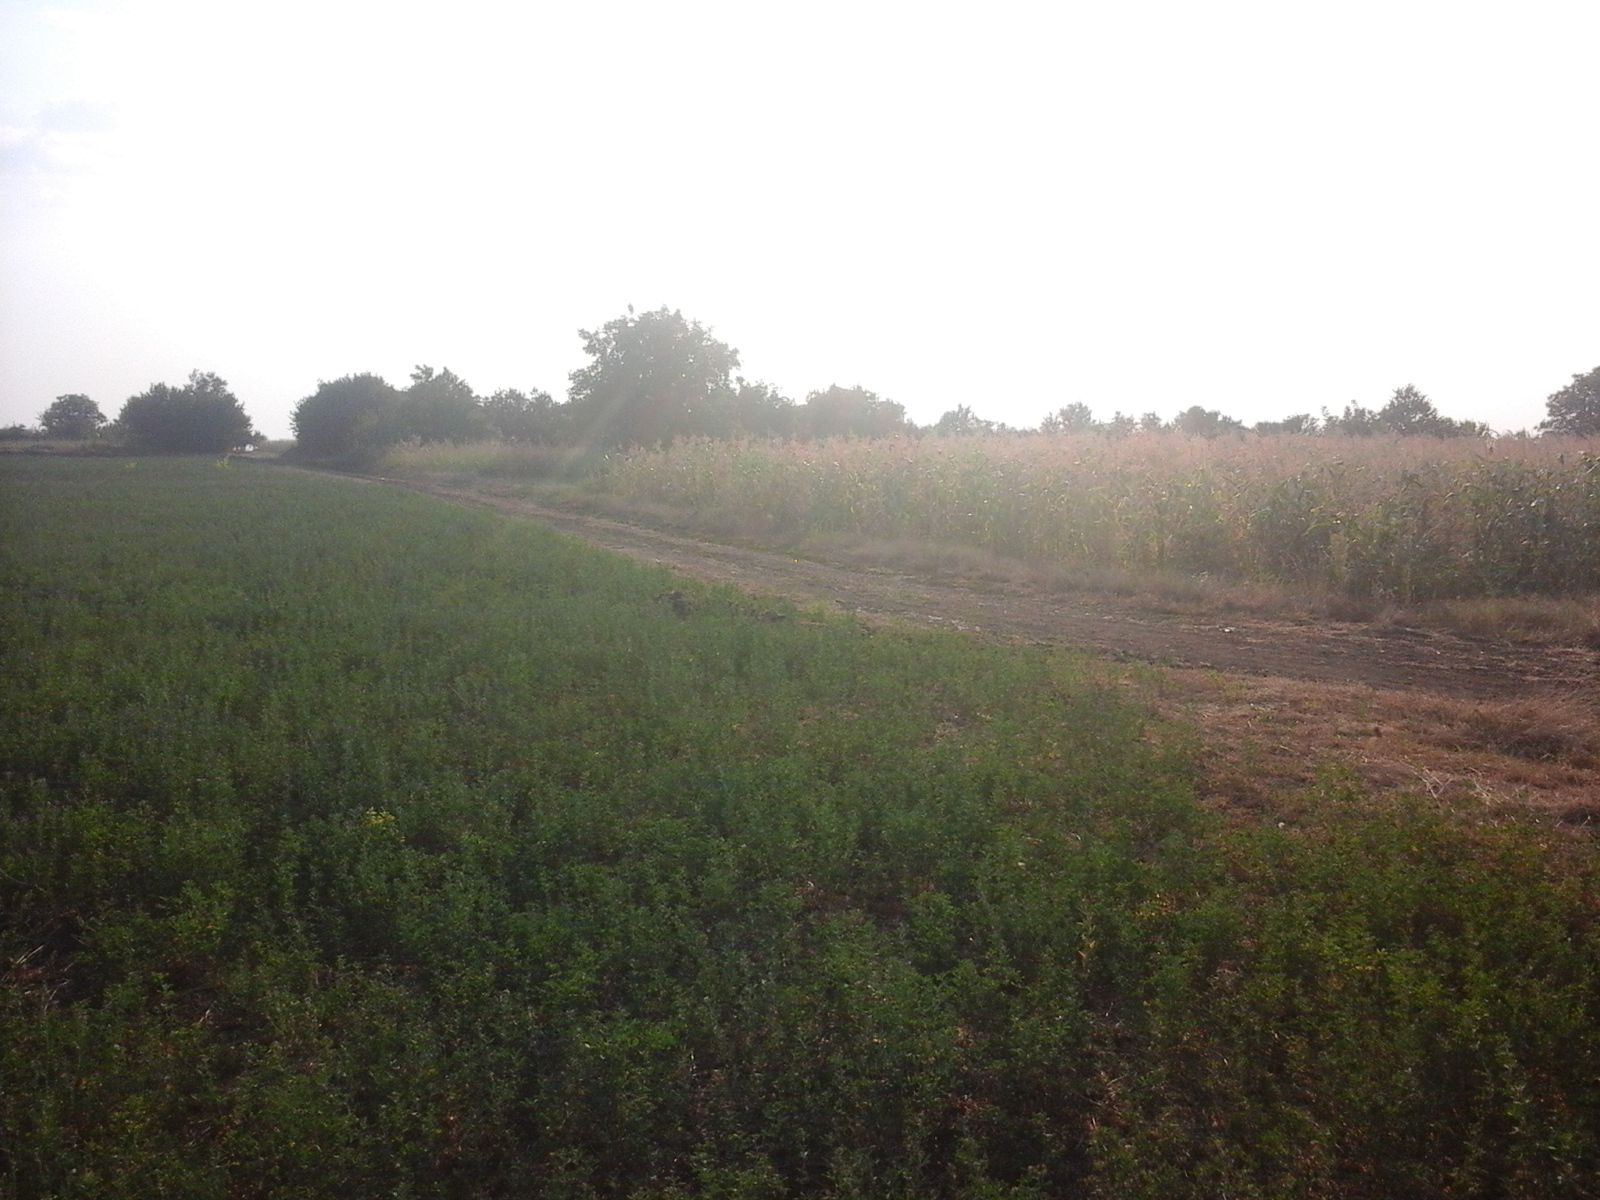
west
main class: Cropland
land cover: Lucerne
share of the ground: > 75 %
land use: Agriculture (excluding fallow land and kitchen gardens)
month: August
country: RO
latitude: 44.1444
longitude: 23.4636
